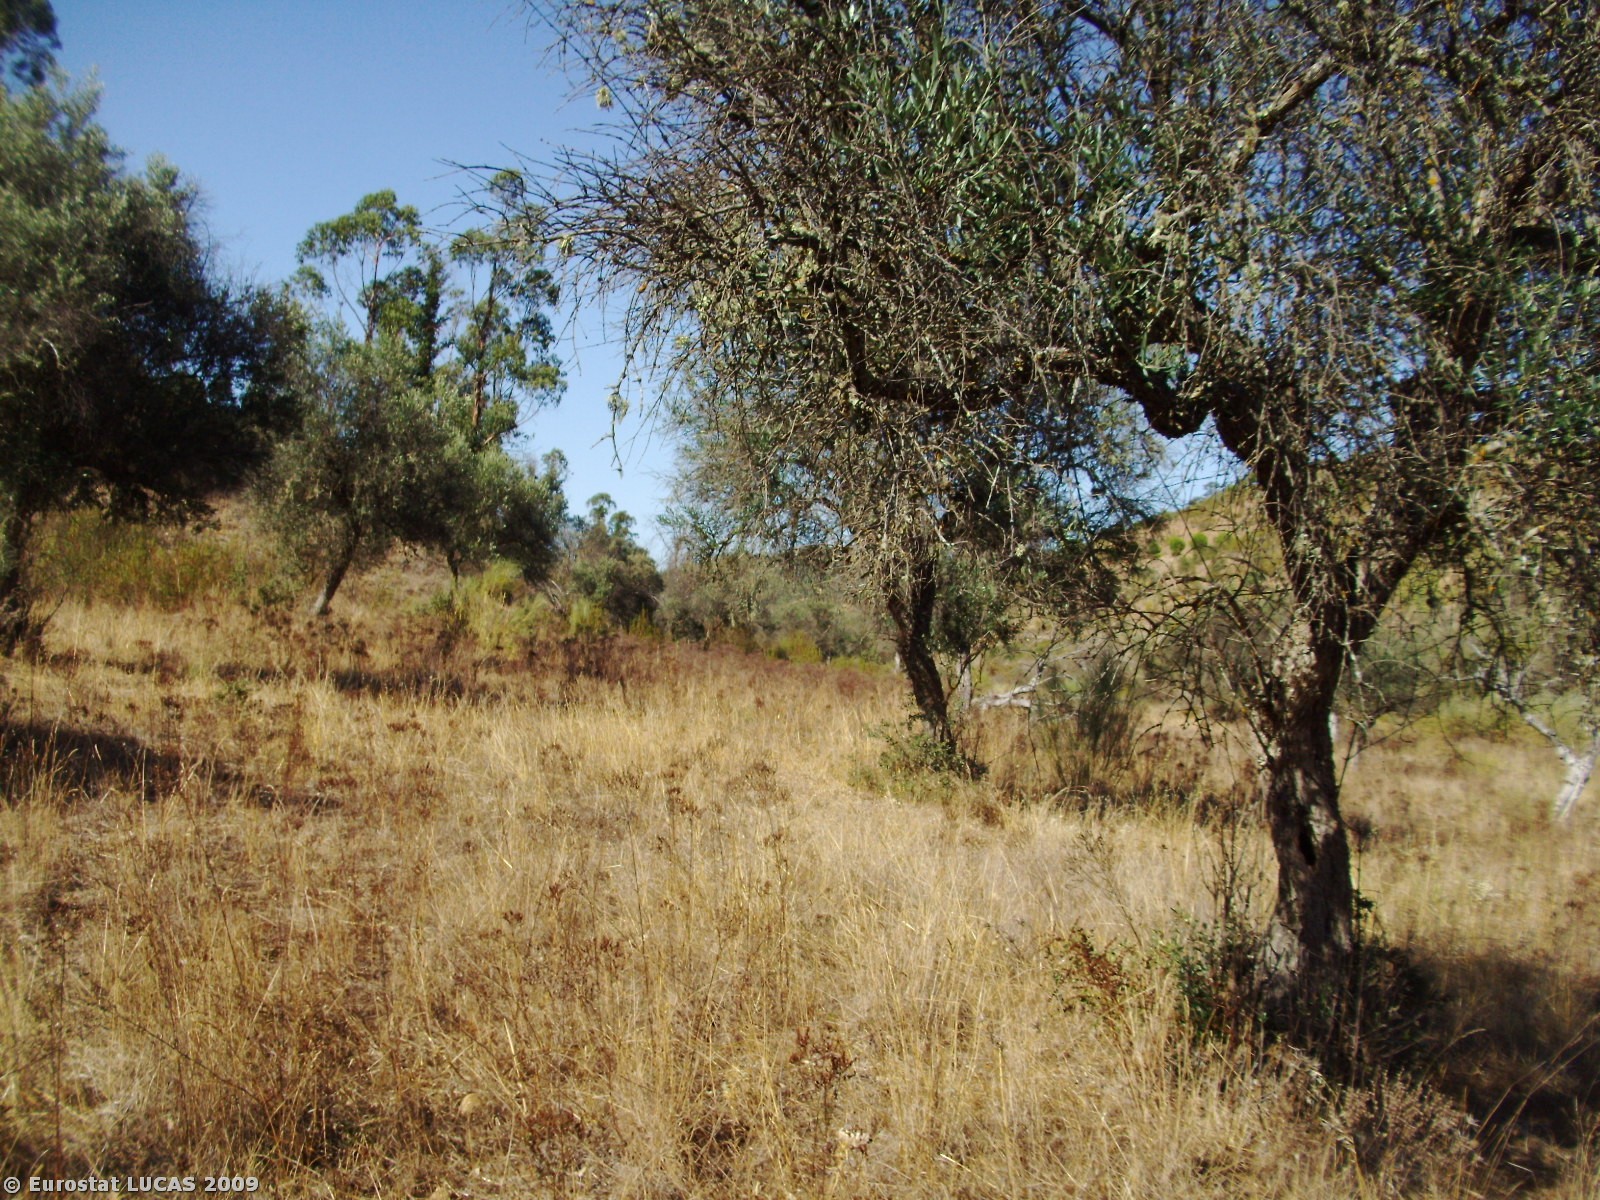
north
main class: Cropland
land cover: Olive groves
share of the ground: 25 - 50 %
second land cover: Spontaneously vegetated surfaces
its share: 50 - 75 %
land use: Agriculture (excluding fallow land and kitchen gardens)
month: May
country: PT
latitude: 39.7514
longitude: -7.4995
